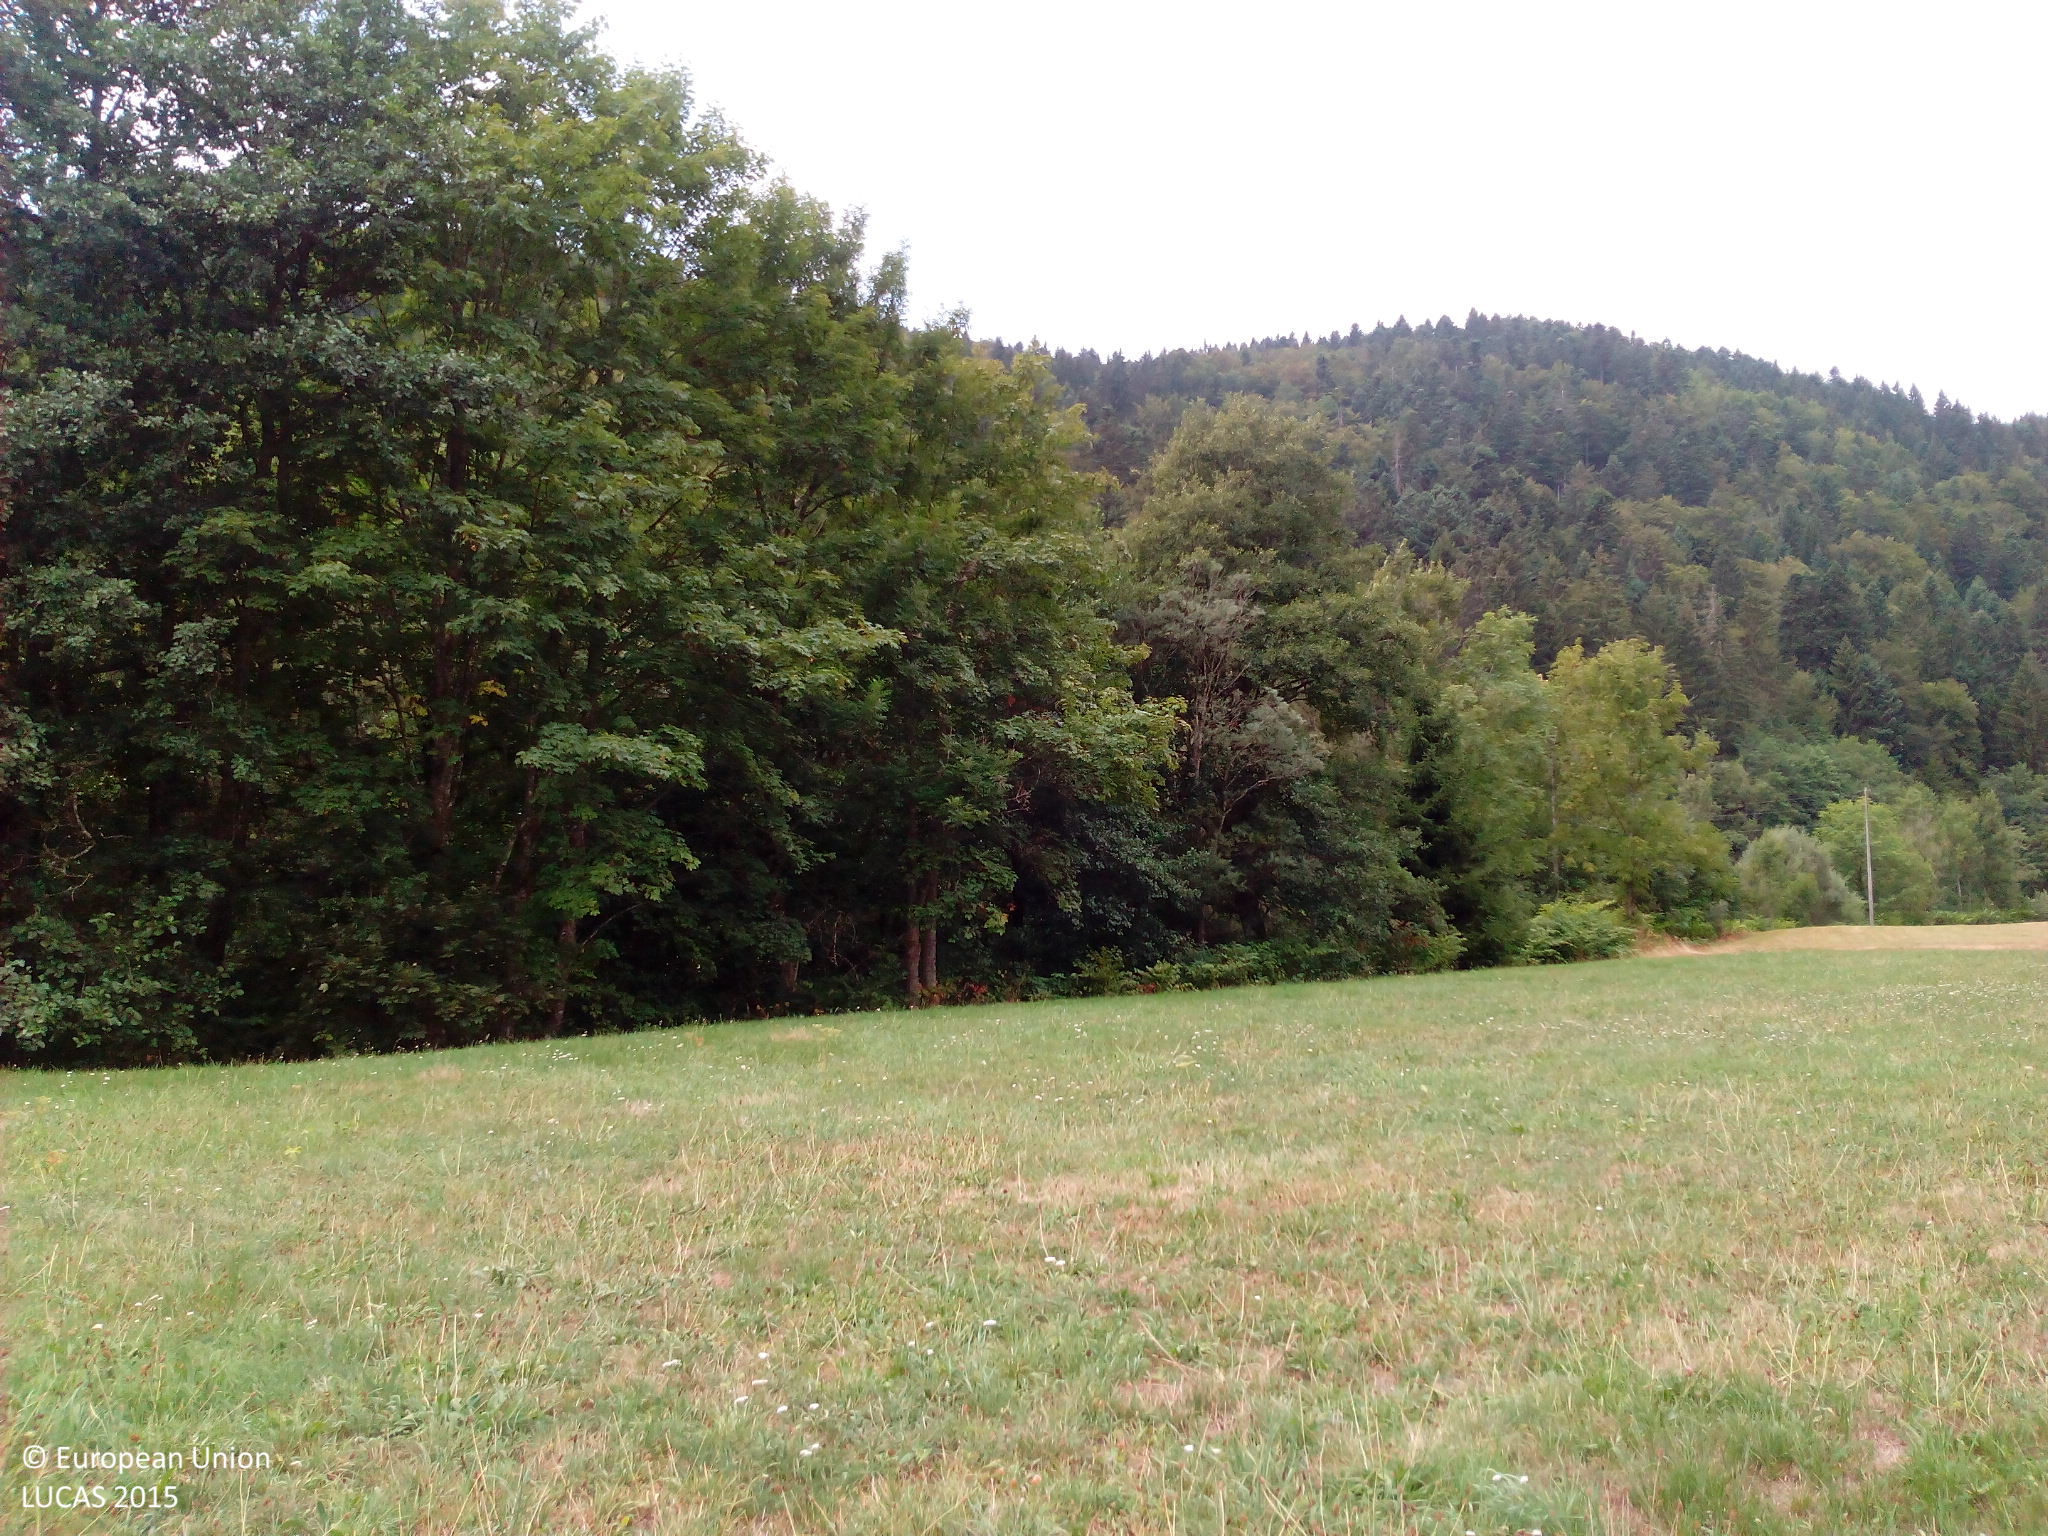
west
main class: Grassland
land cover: Grassland without tree/shrub cover
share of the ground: > 75 %
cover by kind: herbaceous plants 85 %, unconsolidated bare surface 15 %
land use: Agriculture (excluding fallow land and kitchen gardens)
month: August
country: DE
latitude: 47.6855
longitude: 8.1229
